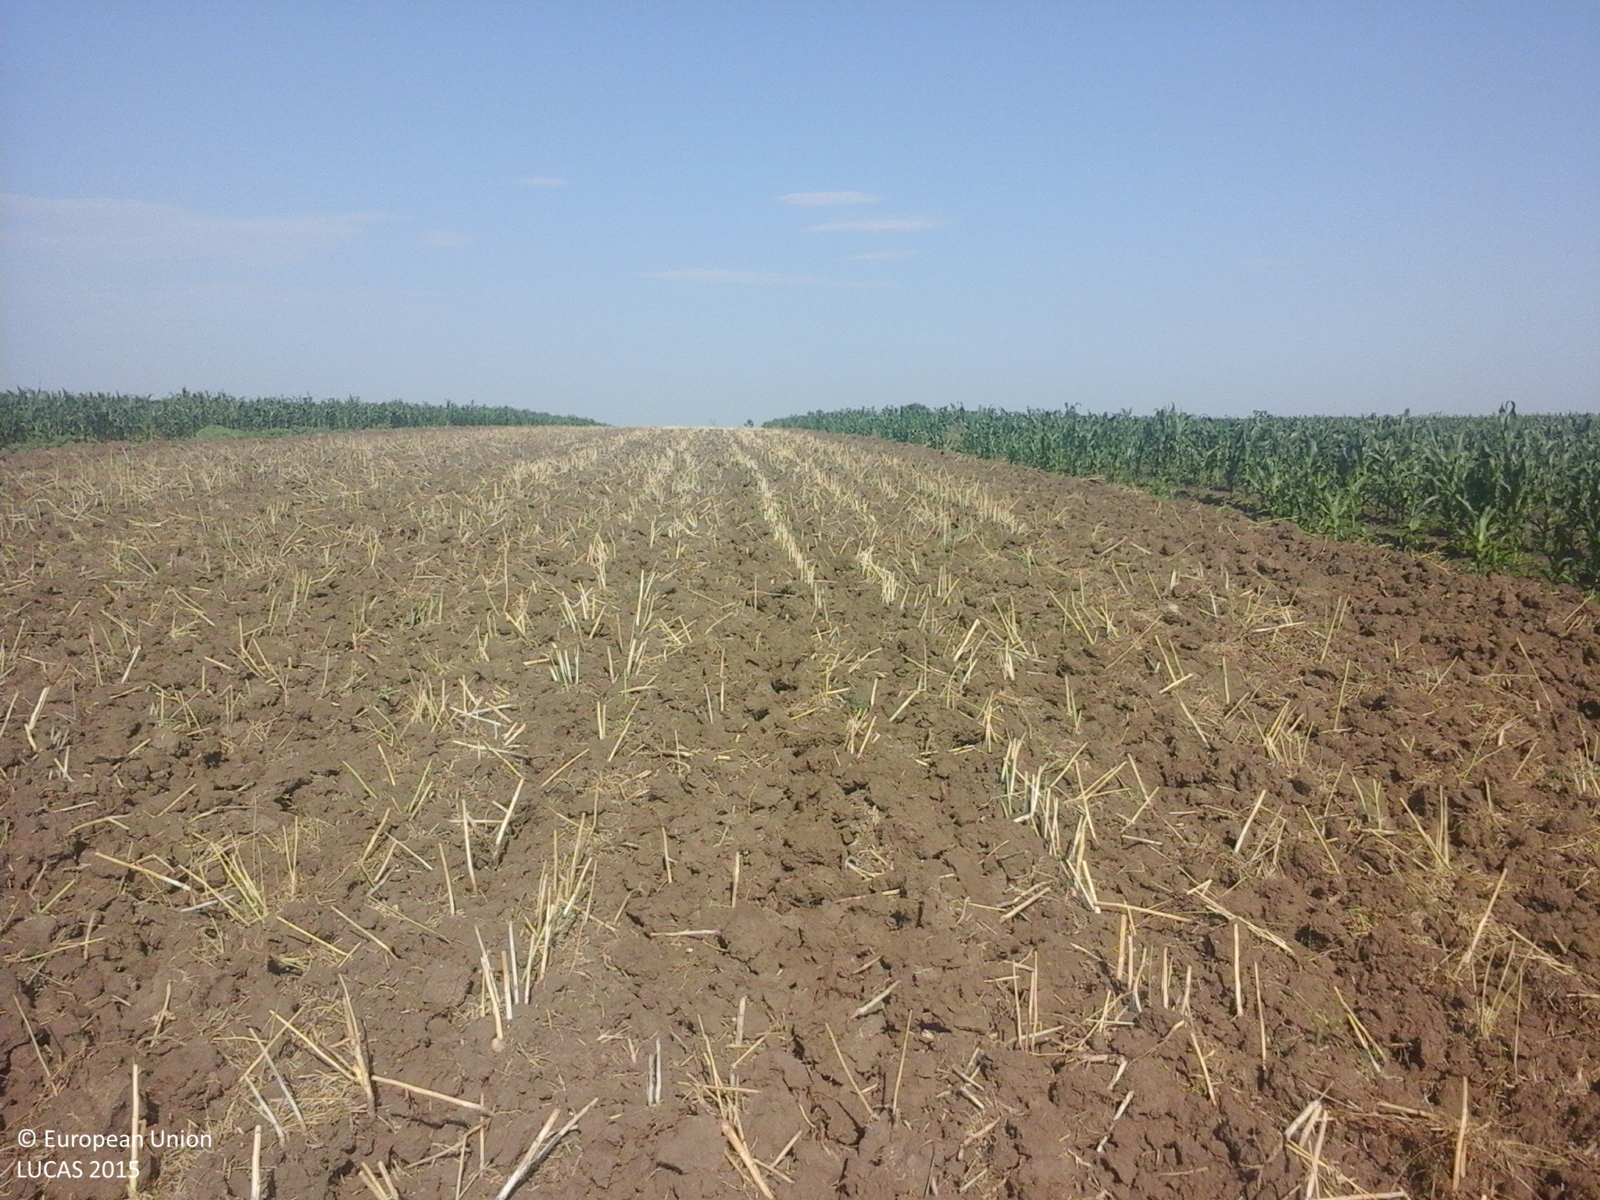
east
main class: Cropland
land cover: Rape and turnip rape
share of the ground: < 10 %
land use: Agriculture (excluding fallow land and kitchen gardens)
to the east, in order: Rape and turnip rape
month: July
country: RO
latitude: 44.6173
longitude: 24.4246
